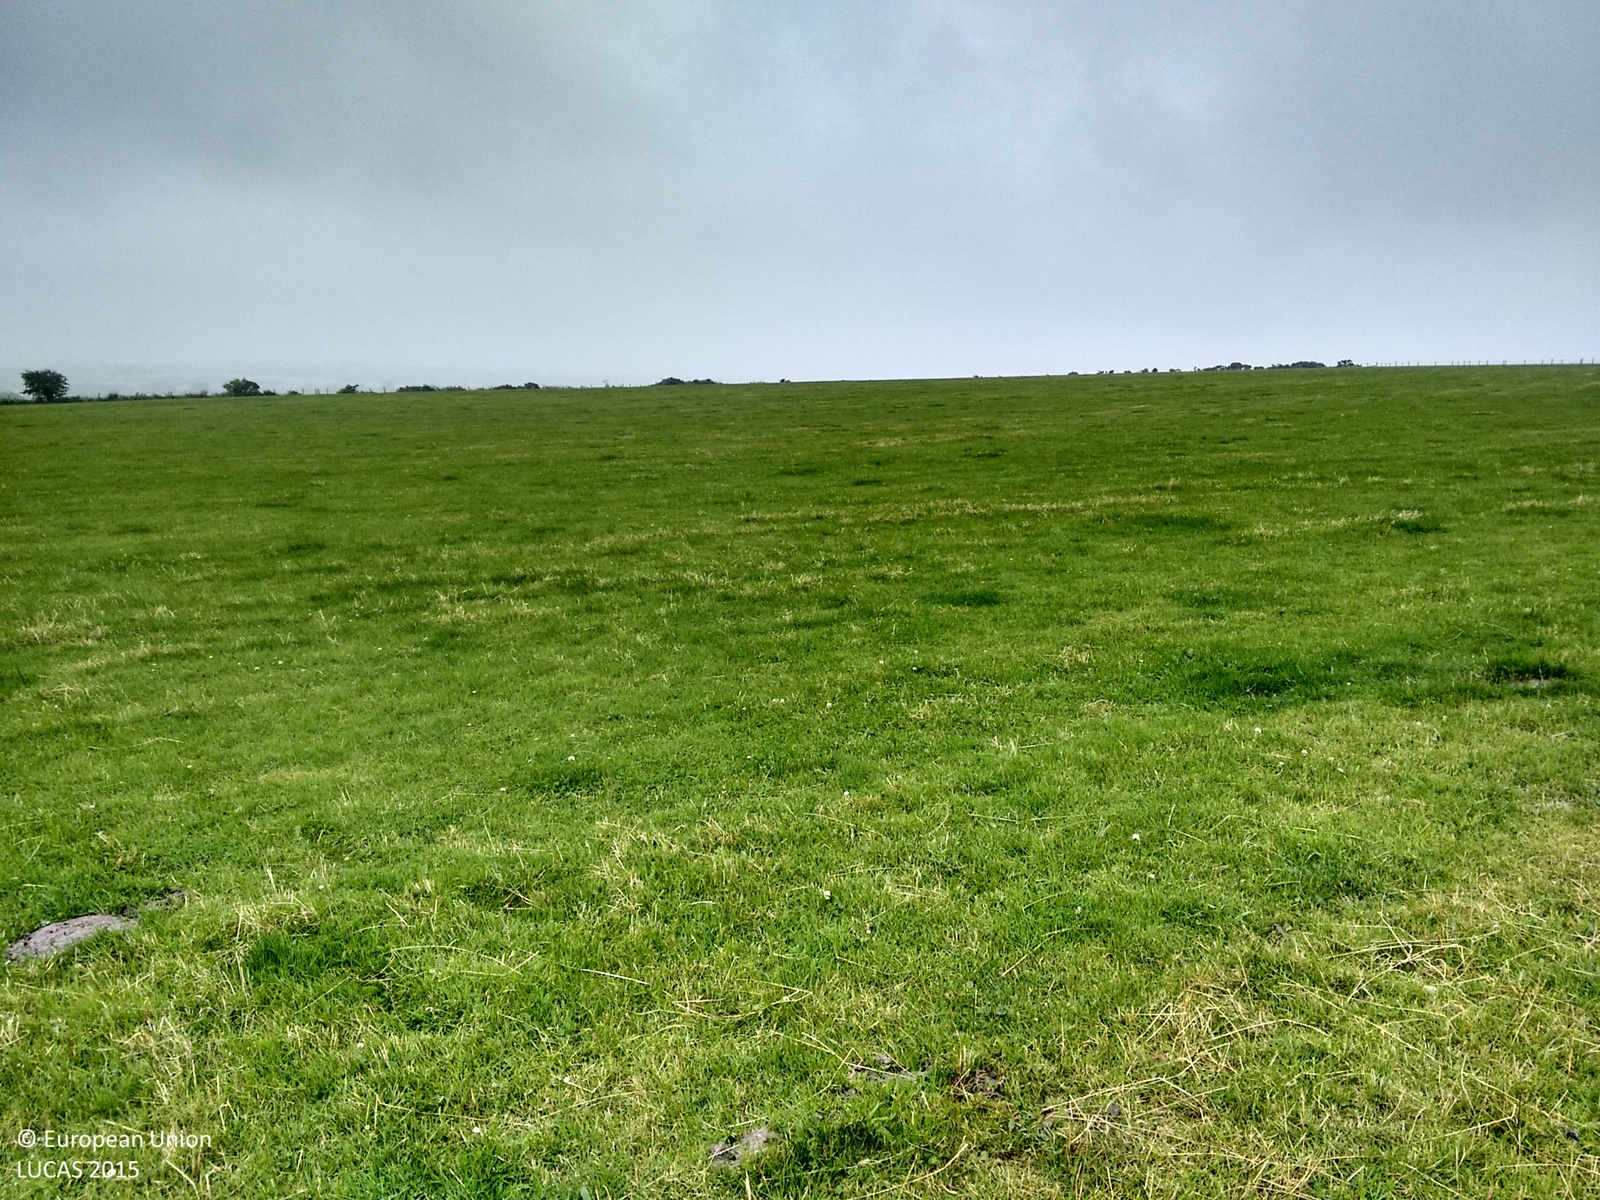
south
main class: Grassland
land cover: Grassland without tree/shrub cover
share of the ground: > 75 %
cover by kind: herbaceous plants 100 %
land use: Agriculture (excluding fallow land and kitchen gardens)
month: August
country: GB
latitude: 51.9528
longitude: -4.5256
